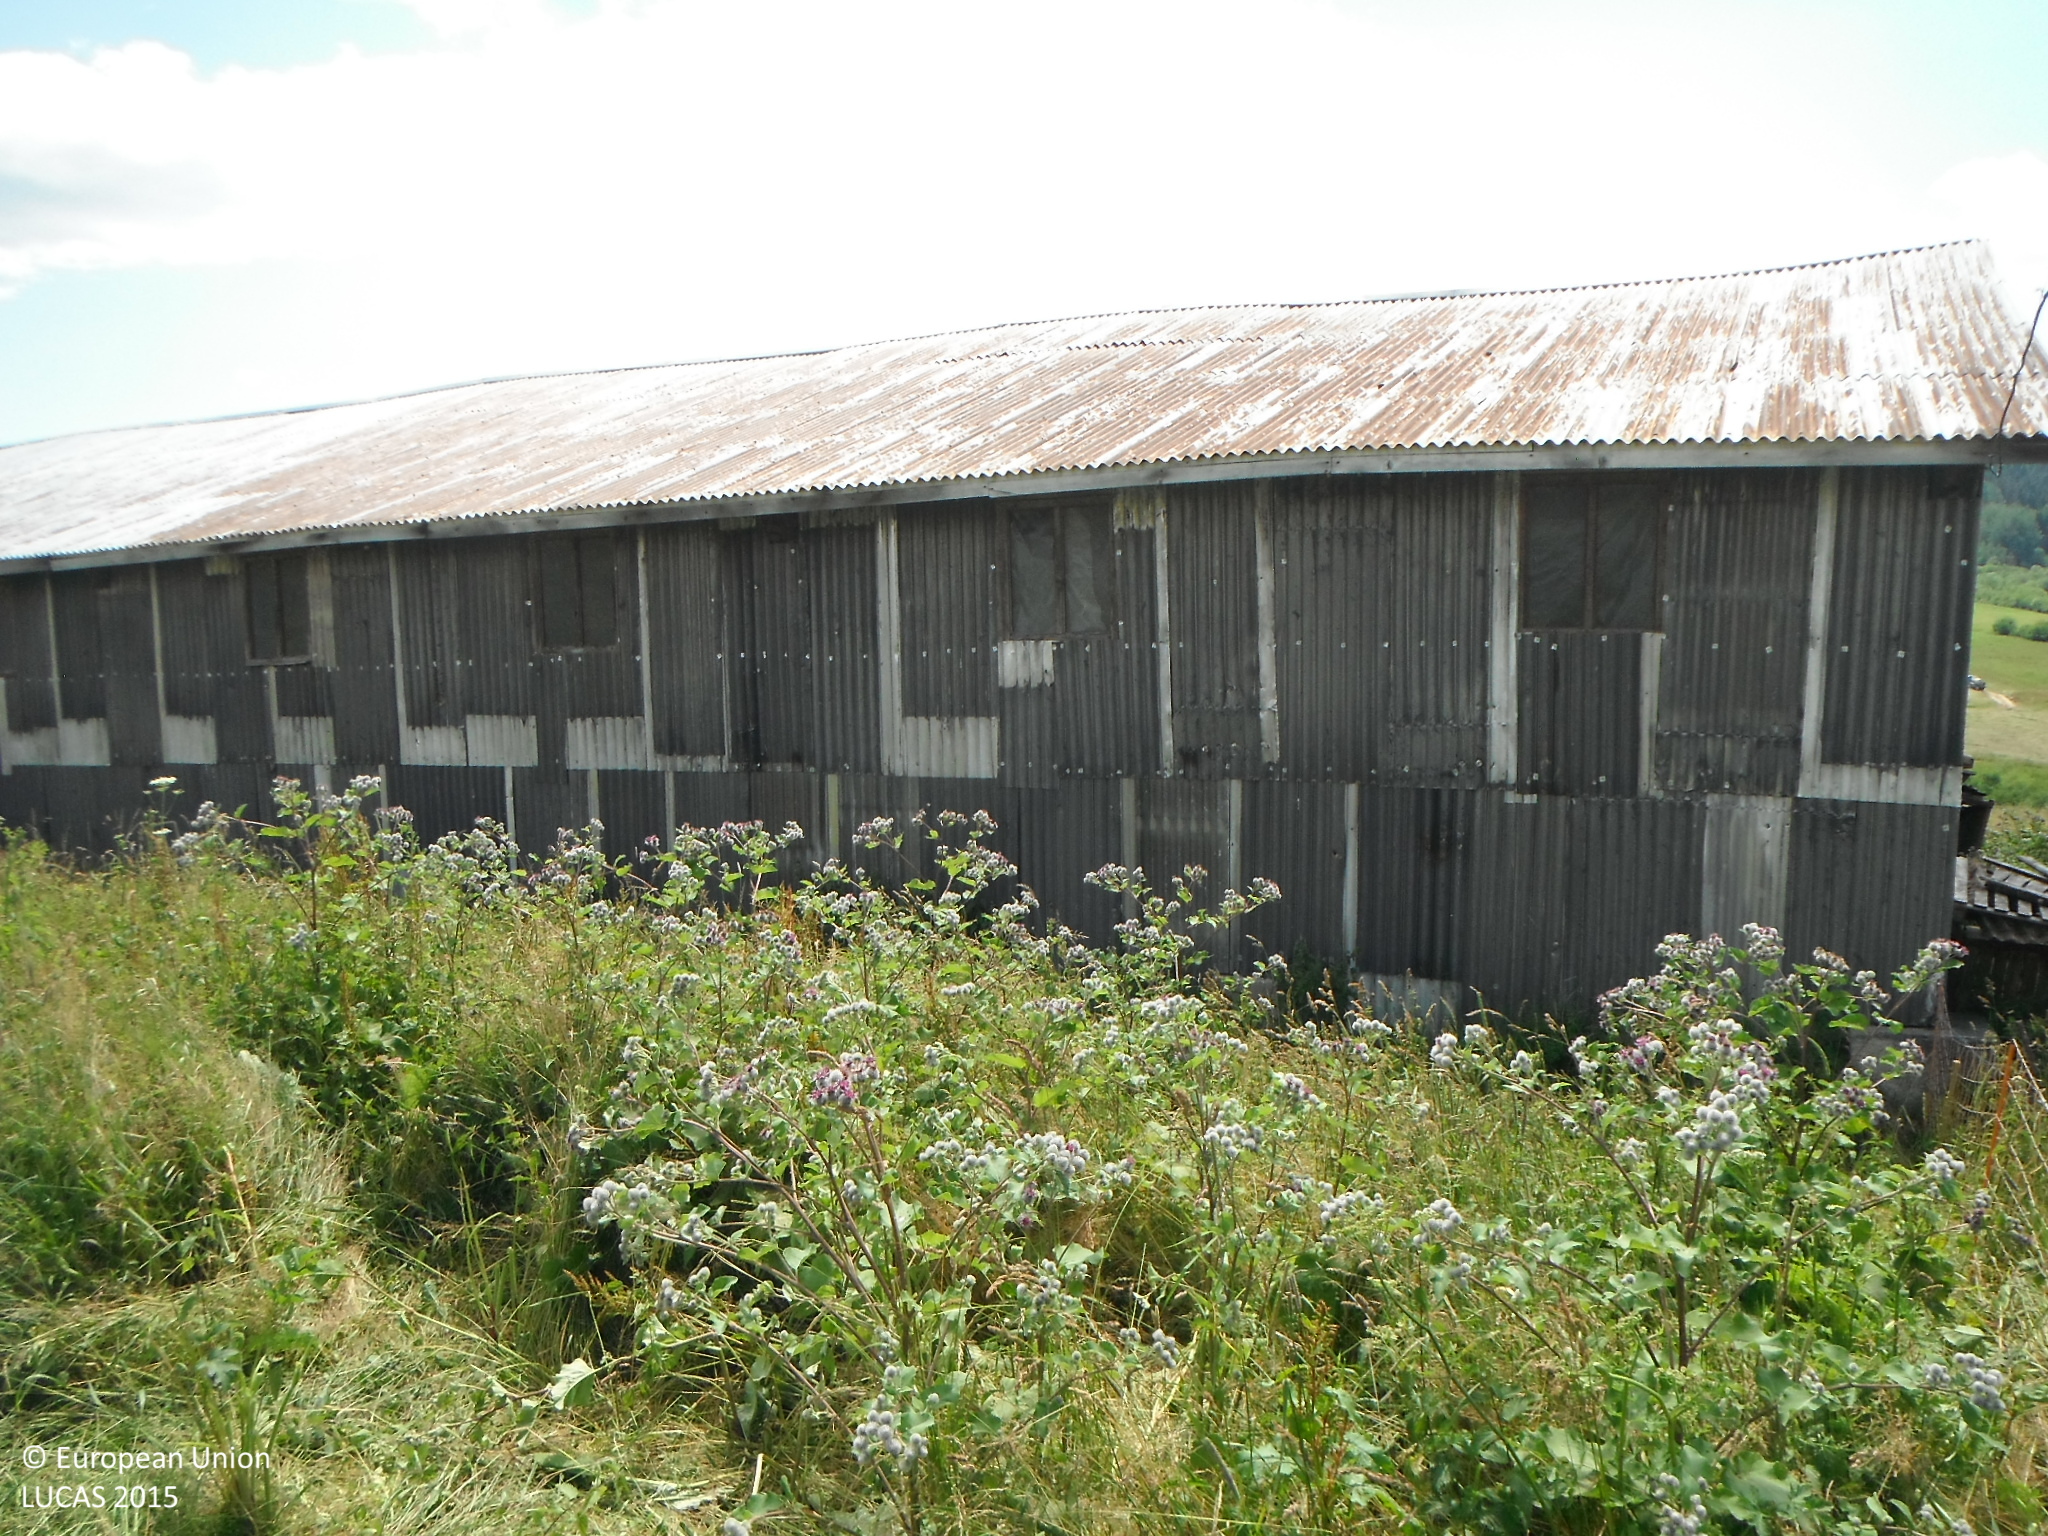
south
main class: Grassland
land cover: Grassland without tree/shrub cover
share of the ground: > 75 %
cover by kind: herbaceous plants 100 %
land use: Agriculture (excluding fallow land and kitchen gardens)
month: July
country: SK
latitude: 49.3656
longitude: 19.7645
